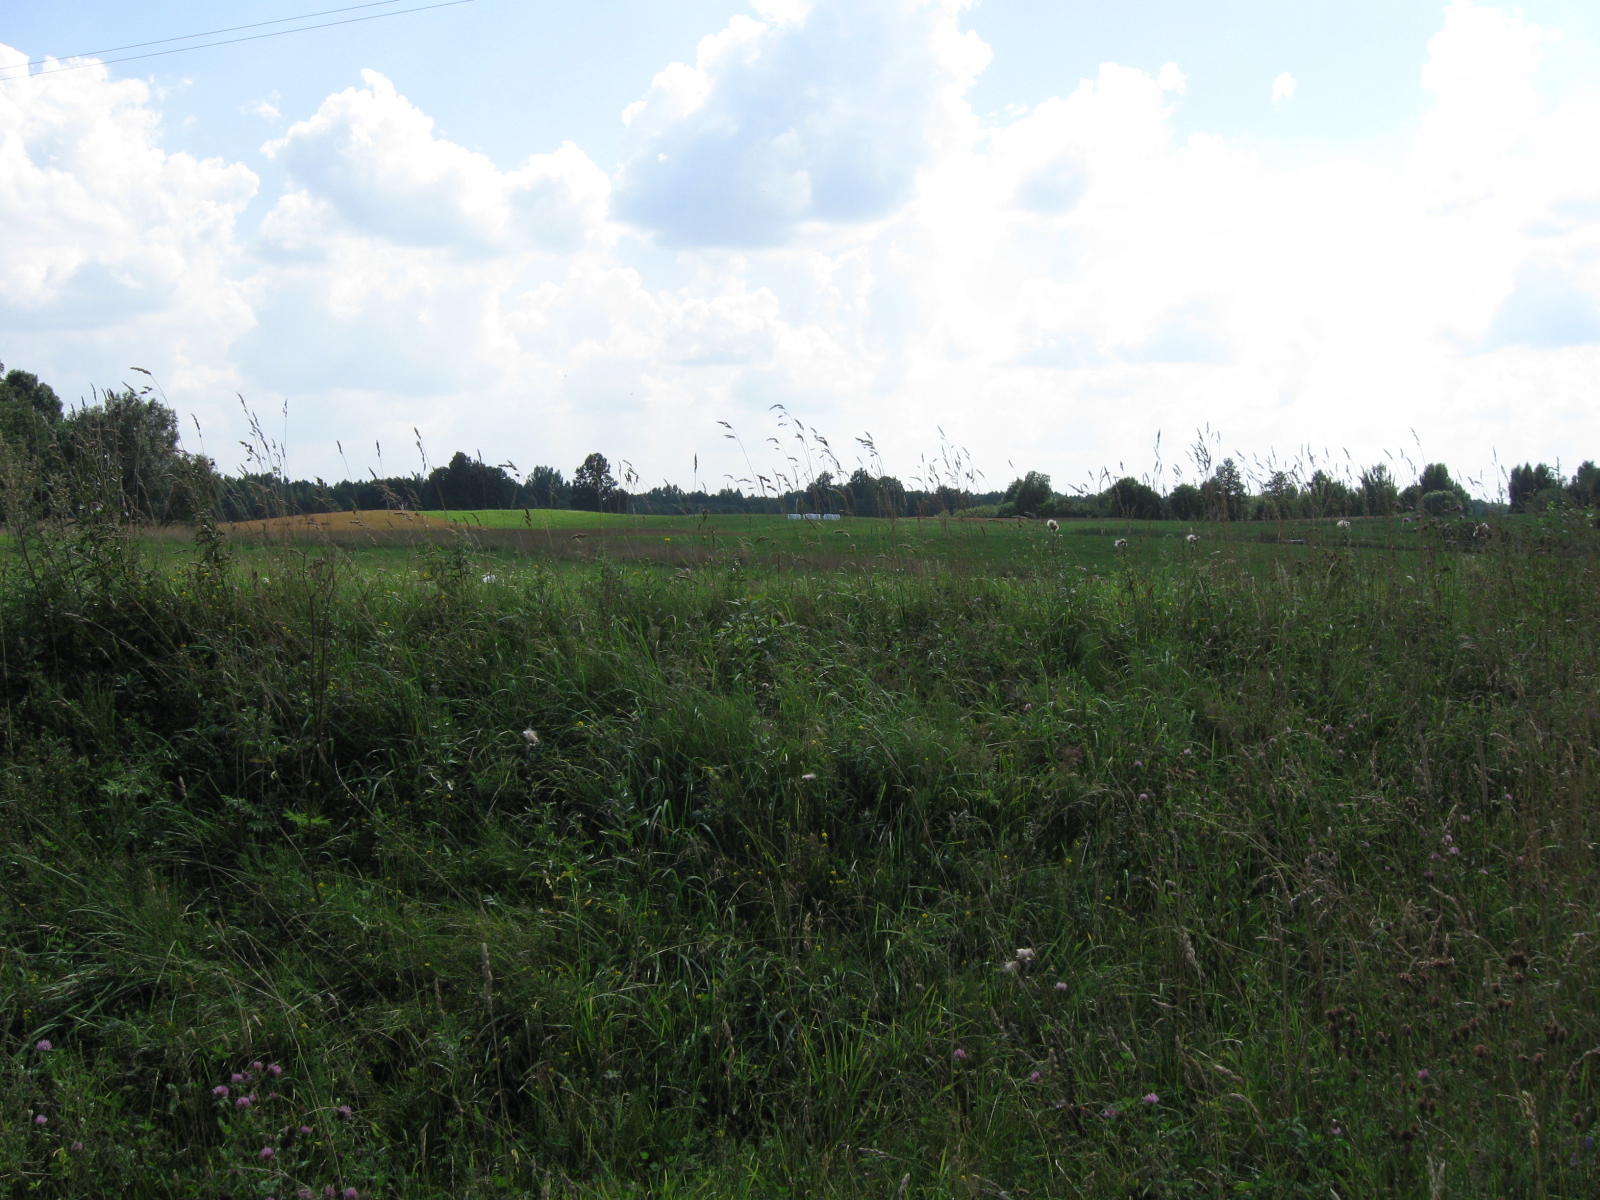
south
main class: Cropland
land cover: Potatoes
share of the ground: > 75 %
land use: Kitchen garden
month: August
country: LT
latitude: 54.7386
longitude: 23.6754
